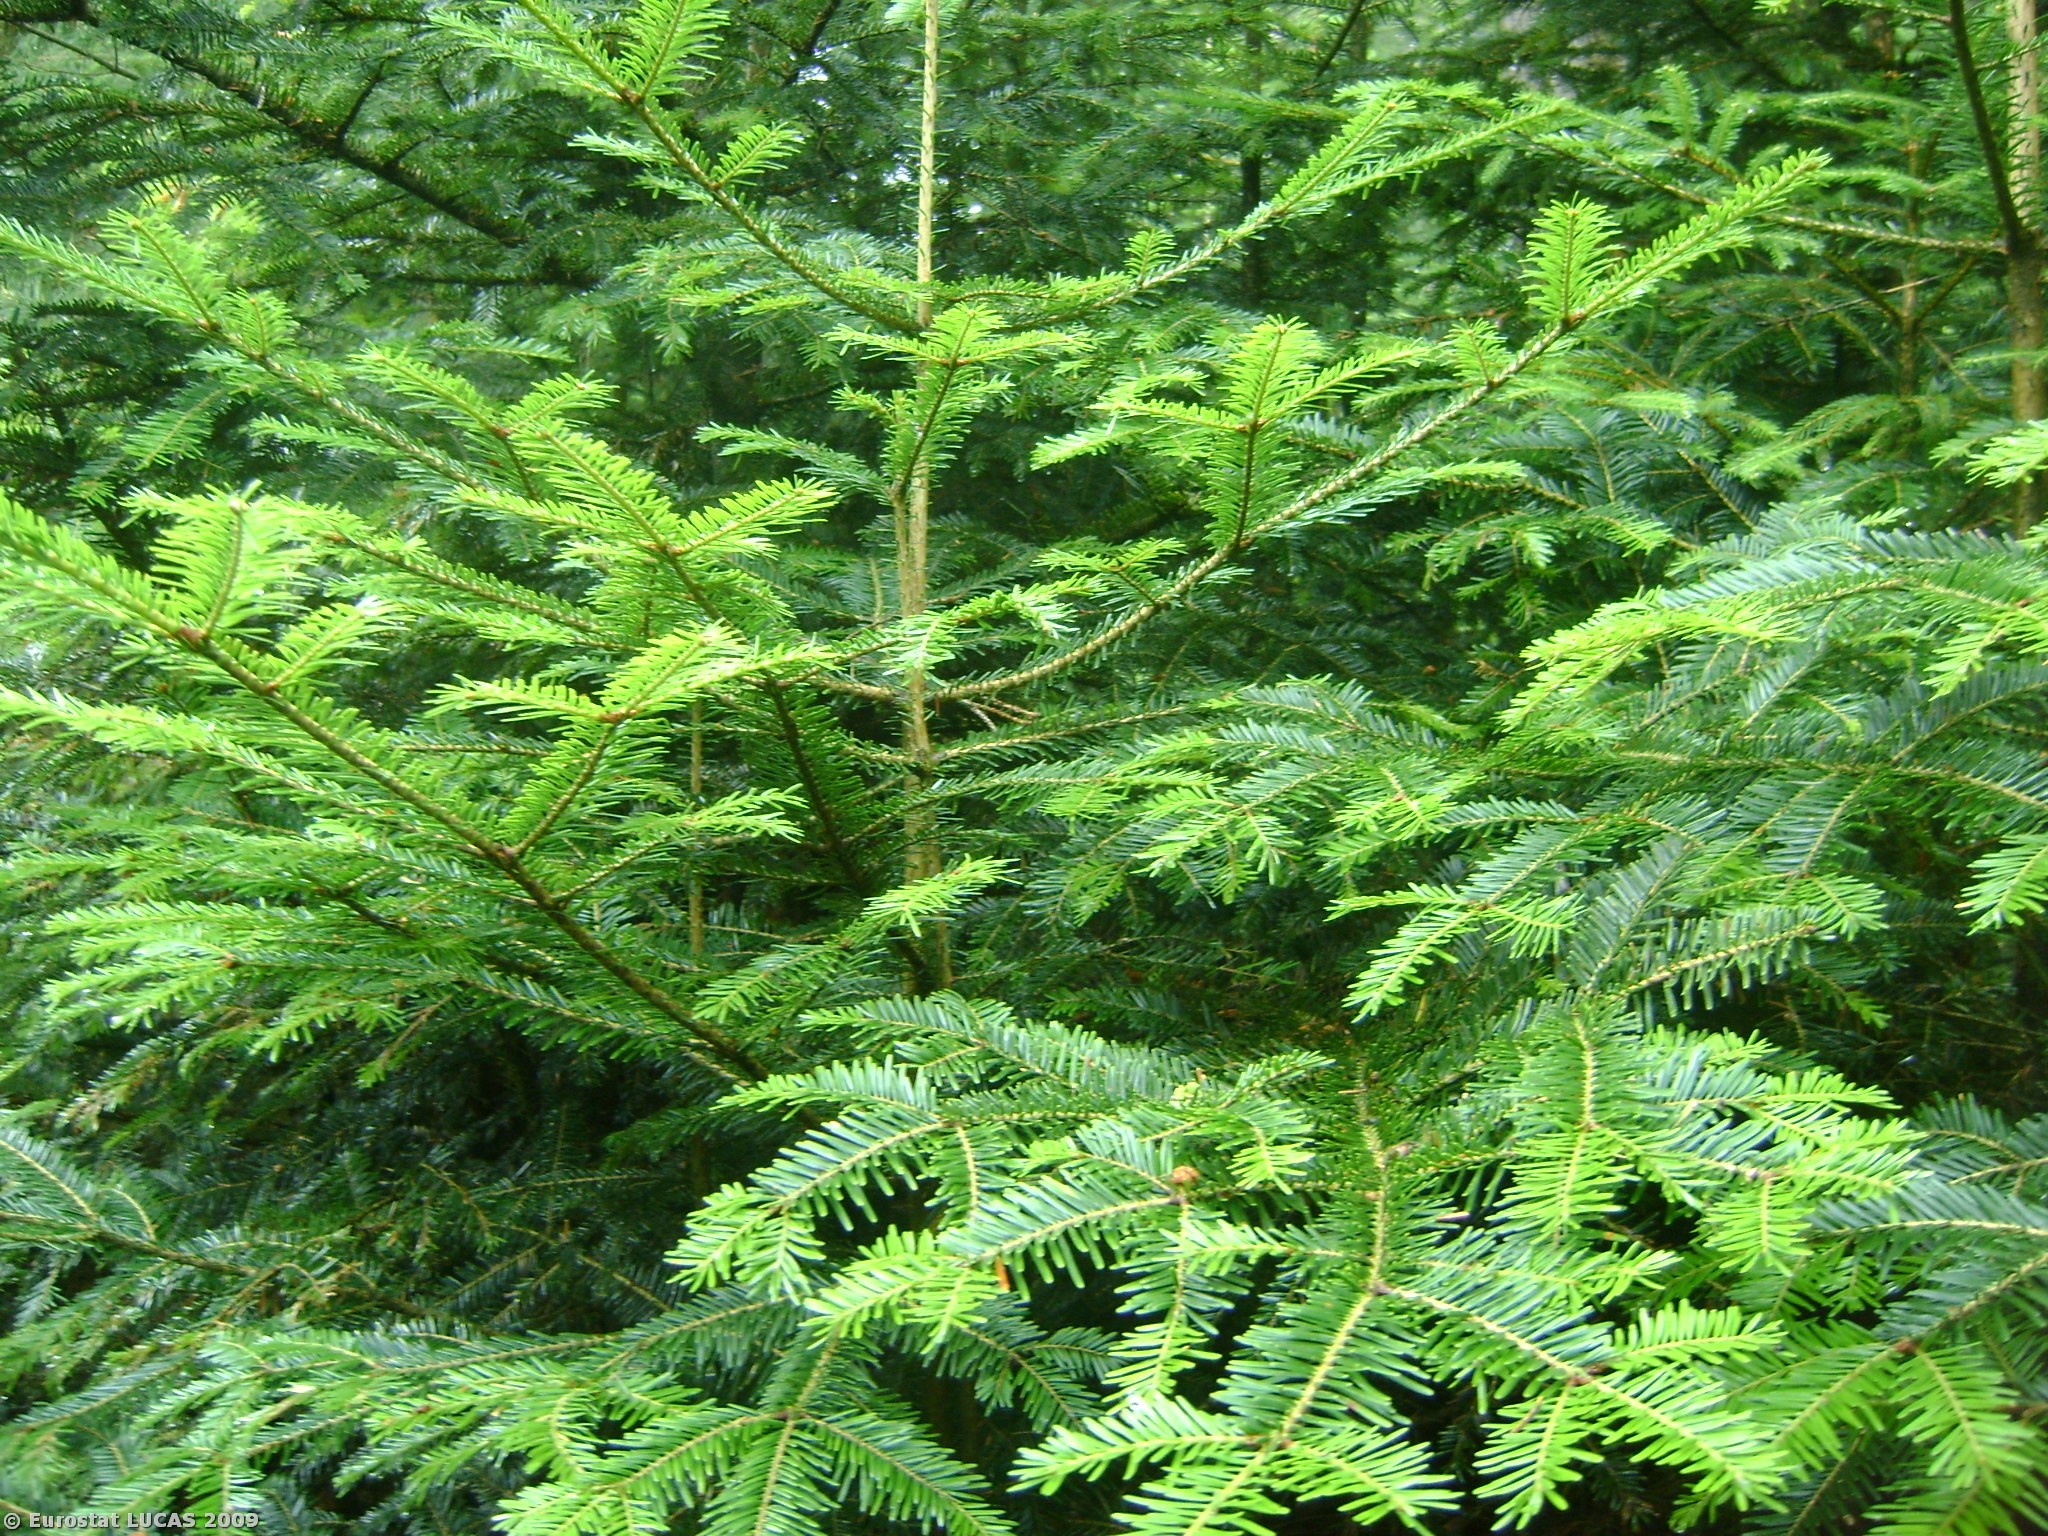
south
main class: Woodland
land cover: Coniferous woodland
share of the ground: > 75 %
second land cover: Shrubland with sparse tree cover
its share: 10 - 25 %
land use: Forestry
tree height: < 5 m
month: June
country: AT
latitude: 48.1041
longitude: 13.2355
